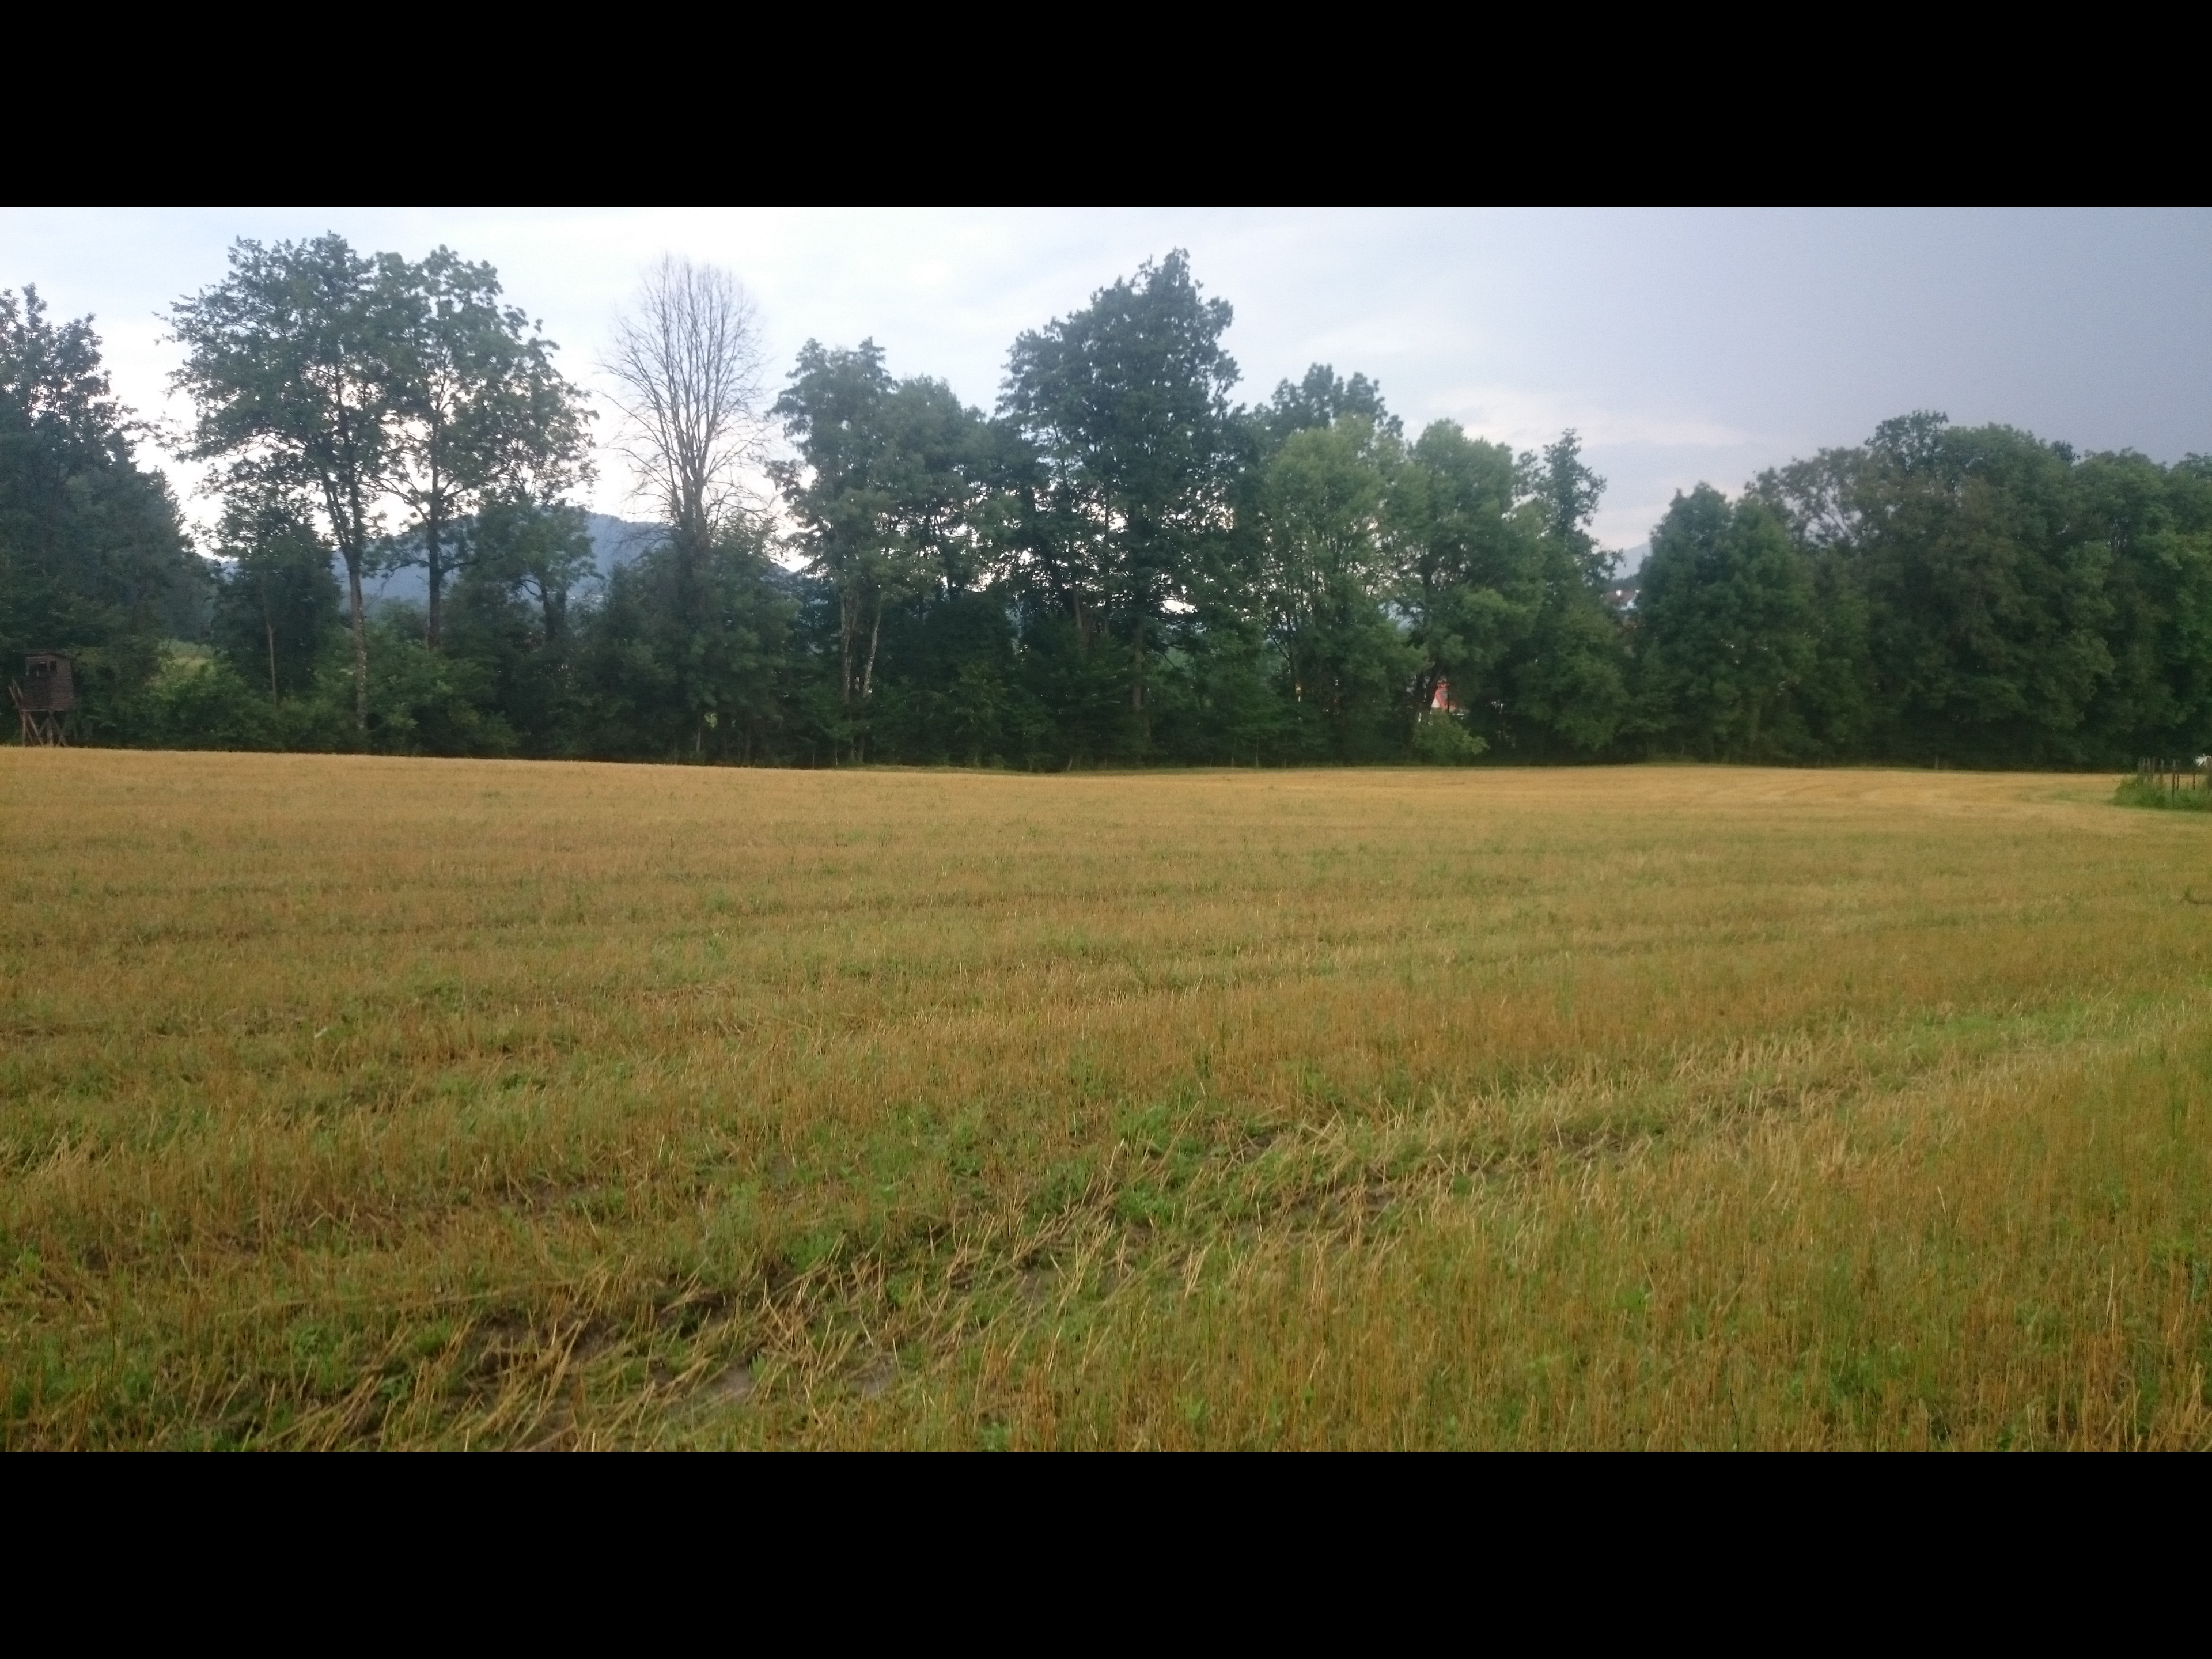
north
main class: Grassland
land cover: Spontaneously vegetated surfaces
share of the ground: > 75 %
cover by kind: herbaceous plants 100 %
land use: Agriculture (excluding fallow land and kitchen gardens)
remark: Harvested field
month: July
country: AT
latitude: 47.1926
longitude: 15.6892
